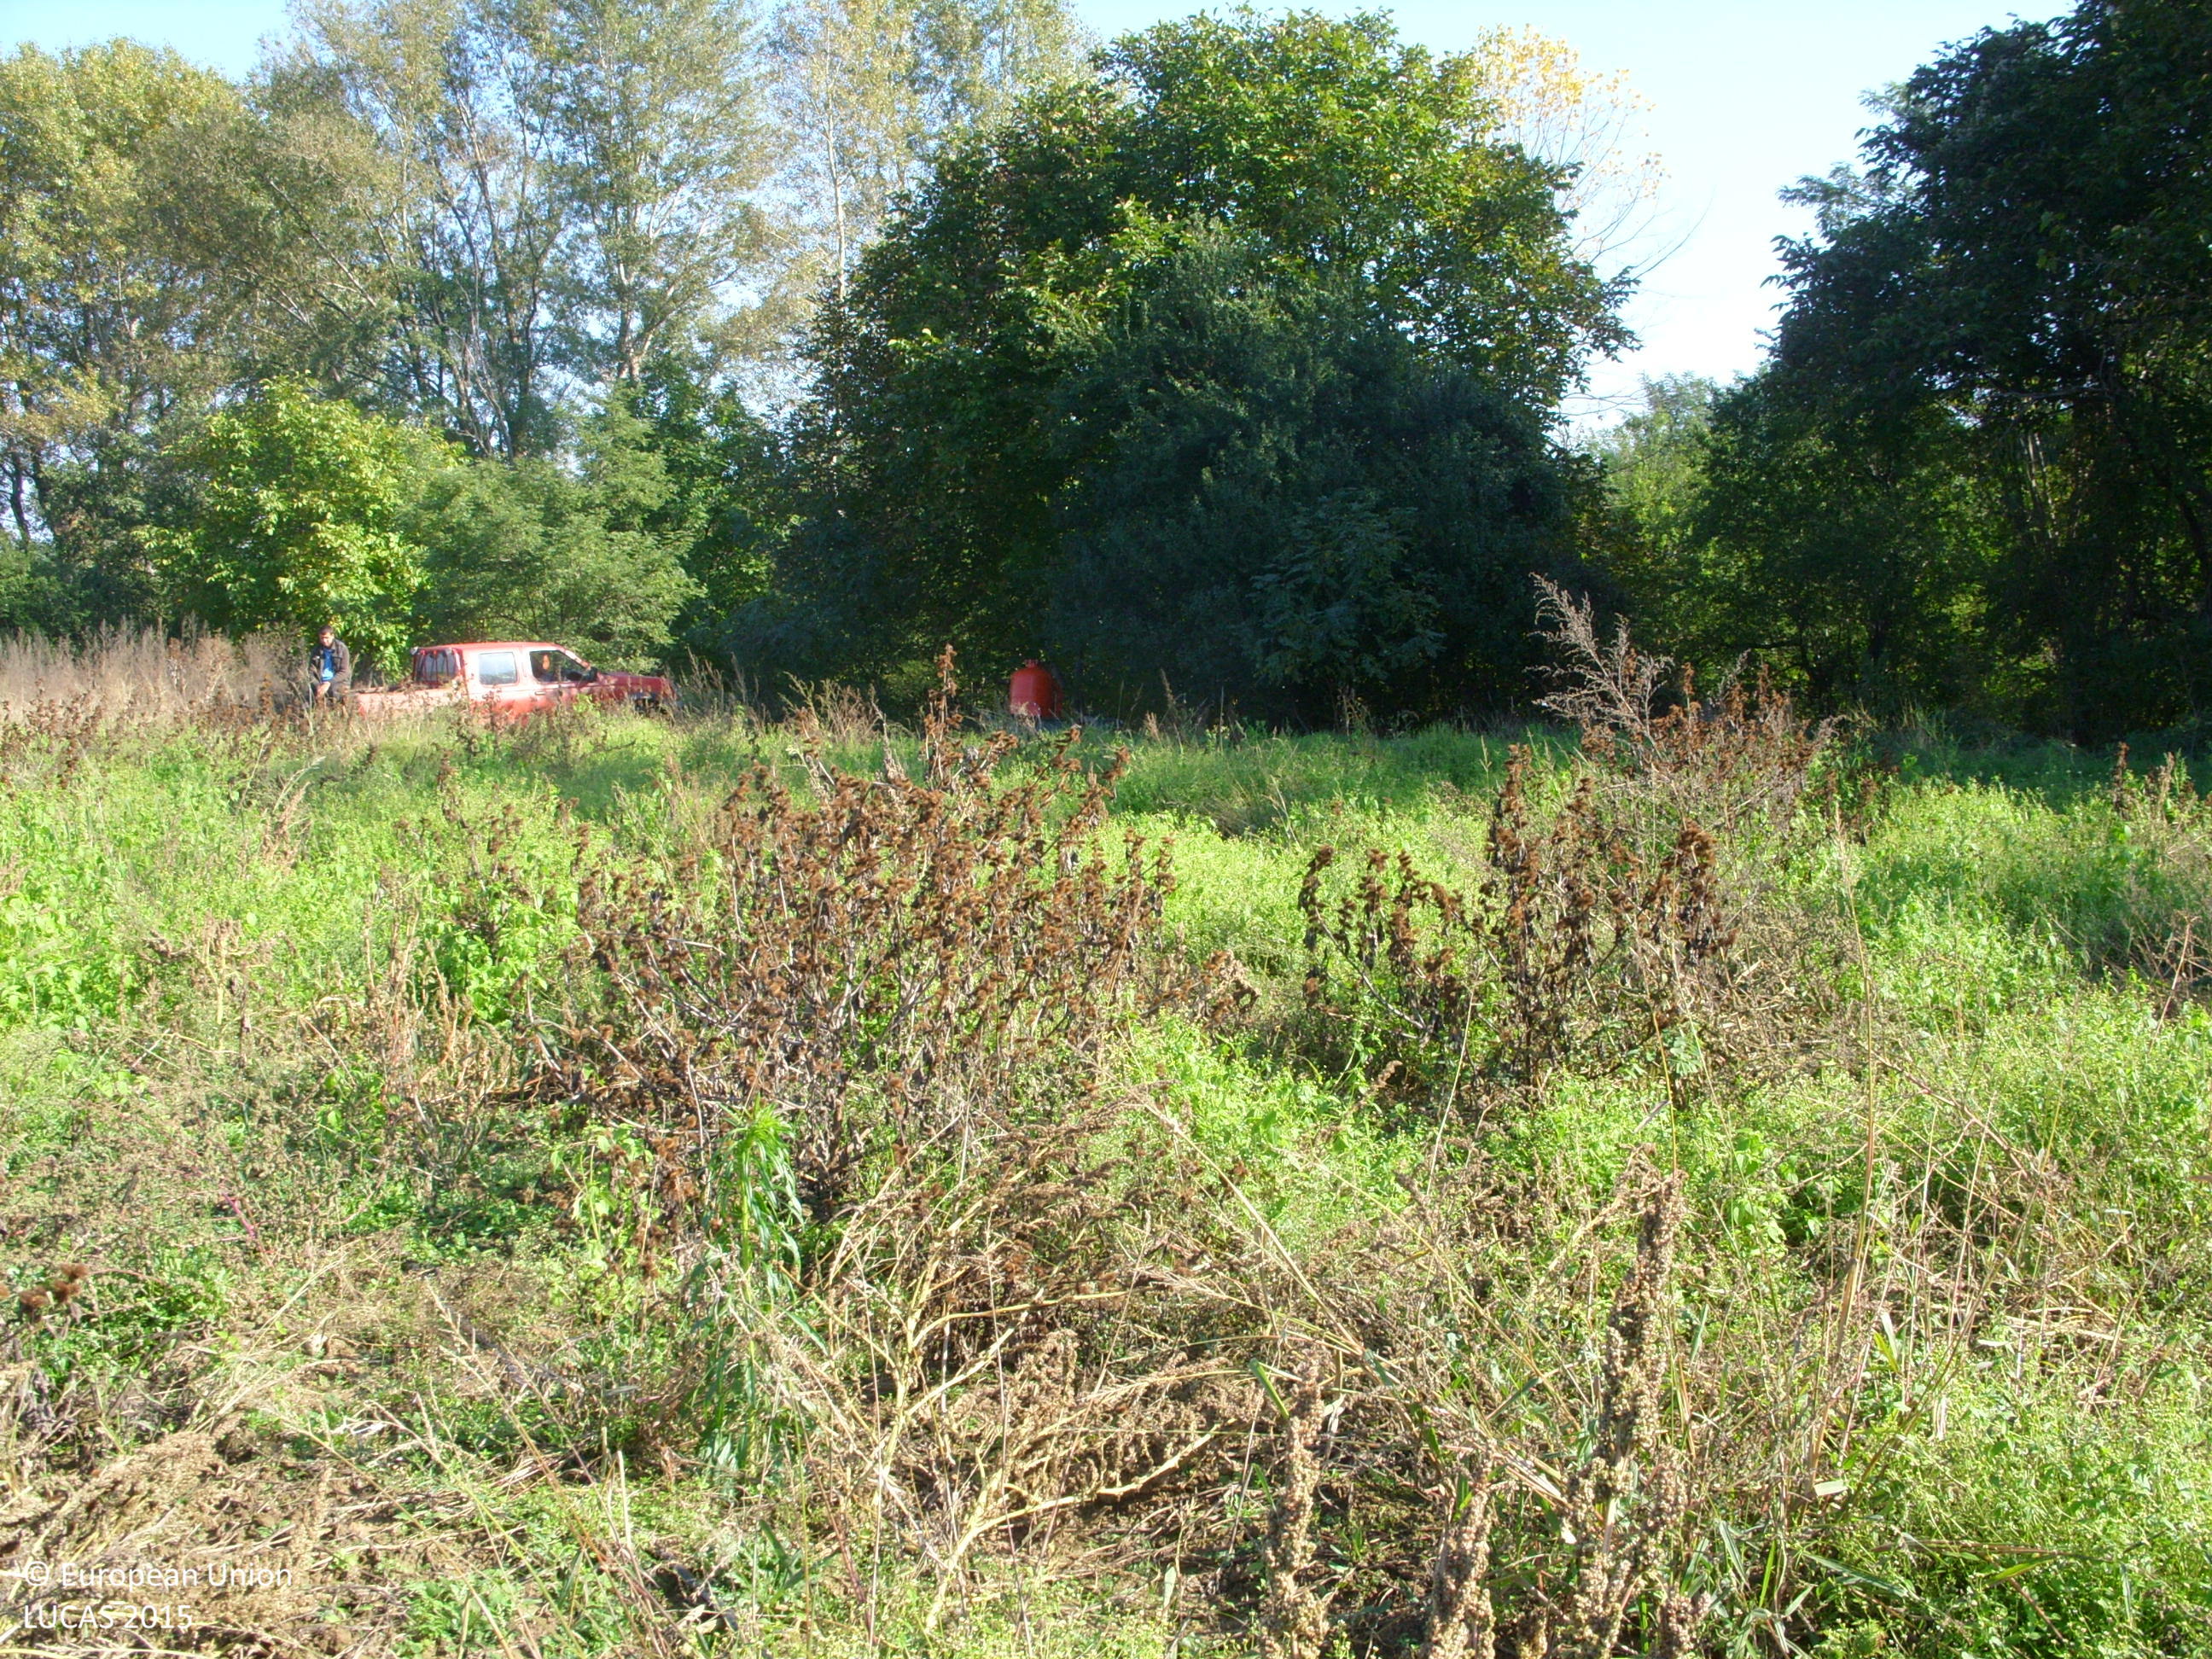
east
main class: Cropland
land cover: Other fresh vegetables
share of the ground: 25 - 50 %
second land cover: Spontaneously vegetated surfaces
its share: 50 - 75 %
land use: Agriculture (excluding fallow land and kitchen gardens)
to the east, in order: Other fresh vegetables; Spontaneously vegetated surfaces; Tracks; Broadleaved woodland; Inland fresh running water; Broadleaved woodland; Tracks; Shrubland with sparse tree cover; Ditches and canals; Shrubland with sparse tree cover; Arable land (only in case pi); Tracks; Arable land (only in case pi)
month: October
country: BG
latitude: 42.6018
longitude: 24.6938
